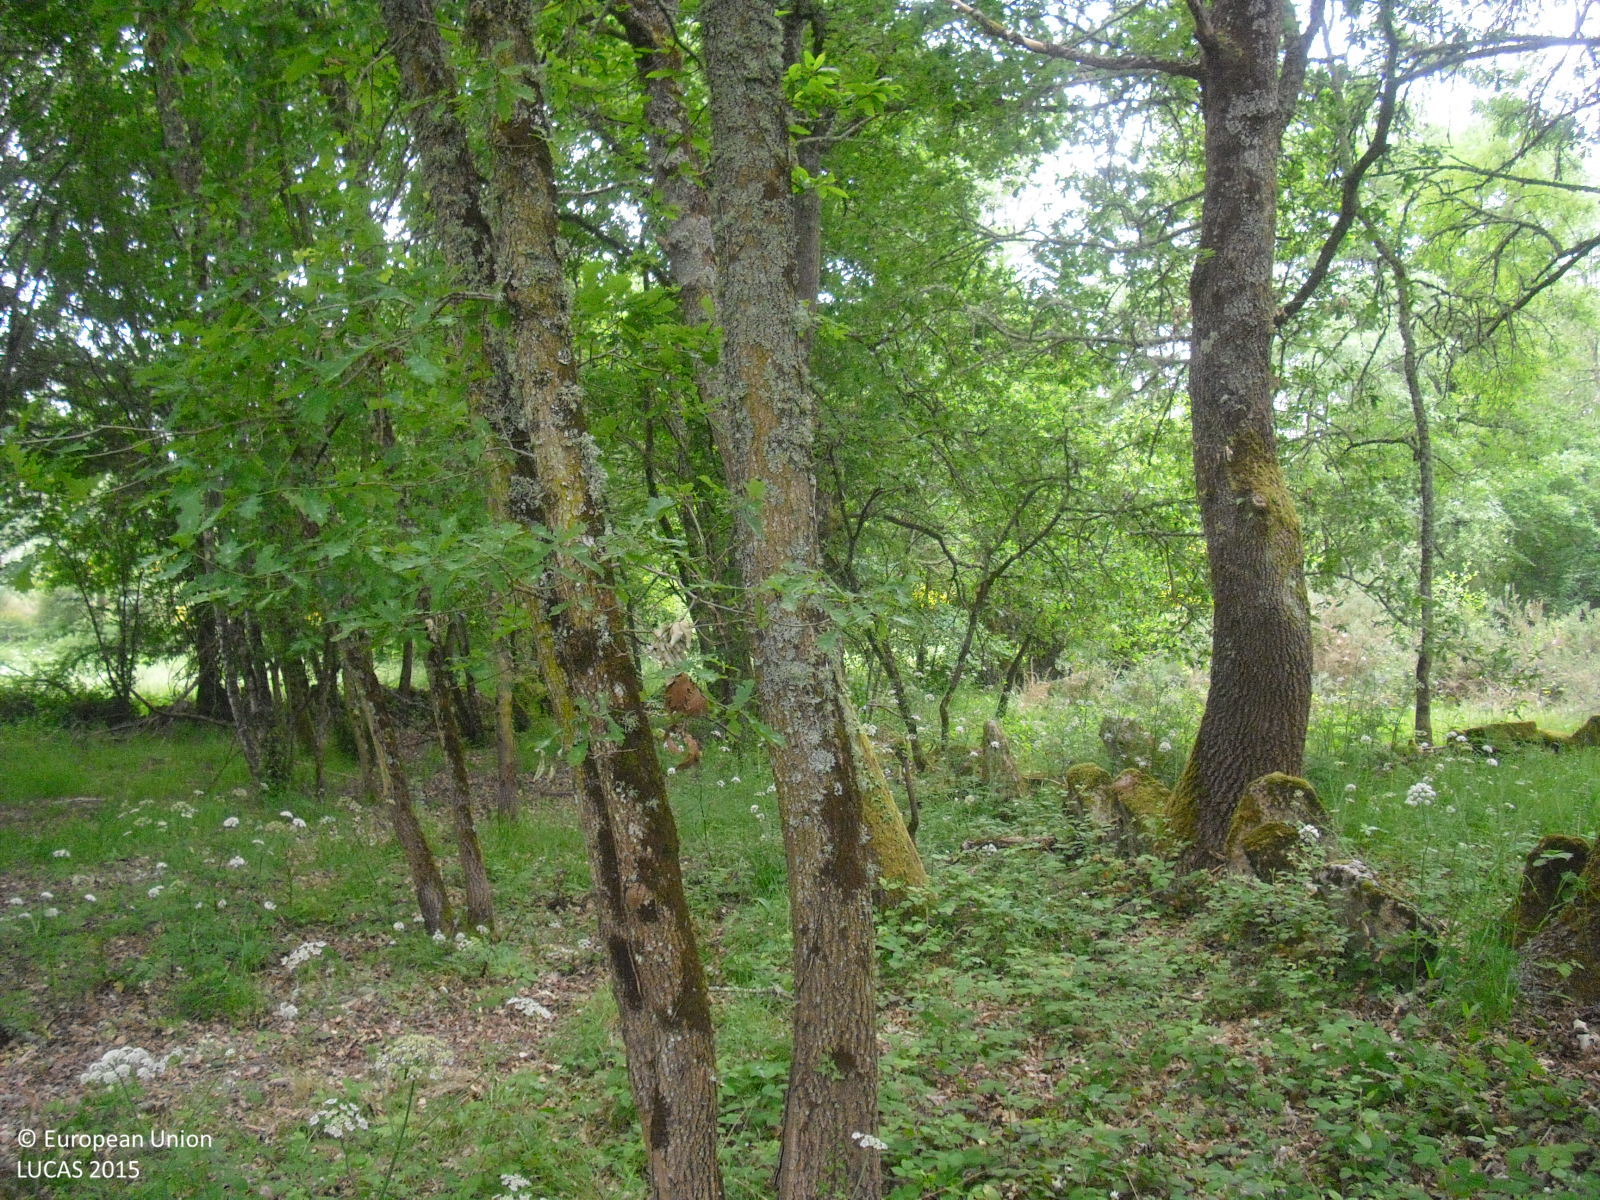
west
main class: Woodland
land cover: Broadleaved woodland
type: acidophilous oak and oak-birch forest
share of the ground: > 75 %
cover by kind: broadleaved forest trees 100 %
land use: Forestry
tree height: > 5 m
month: May
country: ES
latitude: 42.1988
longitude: -7.8407
